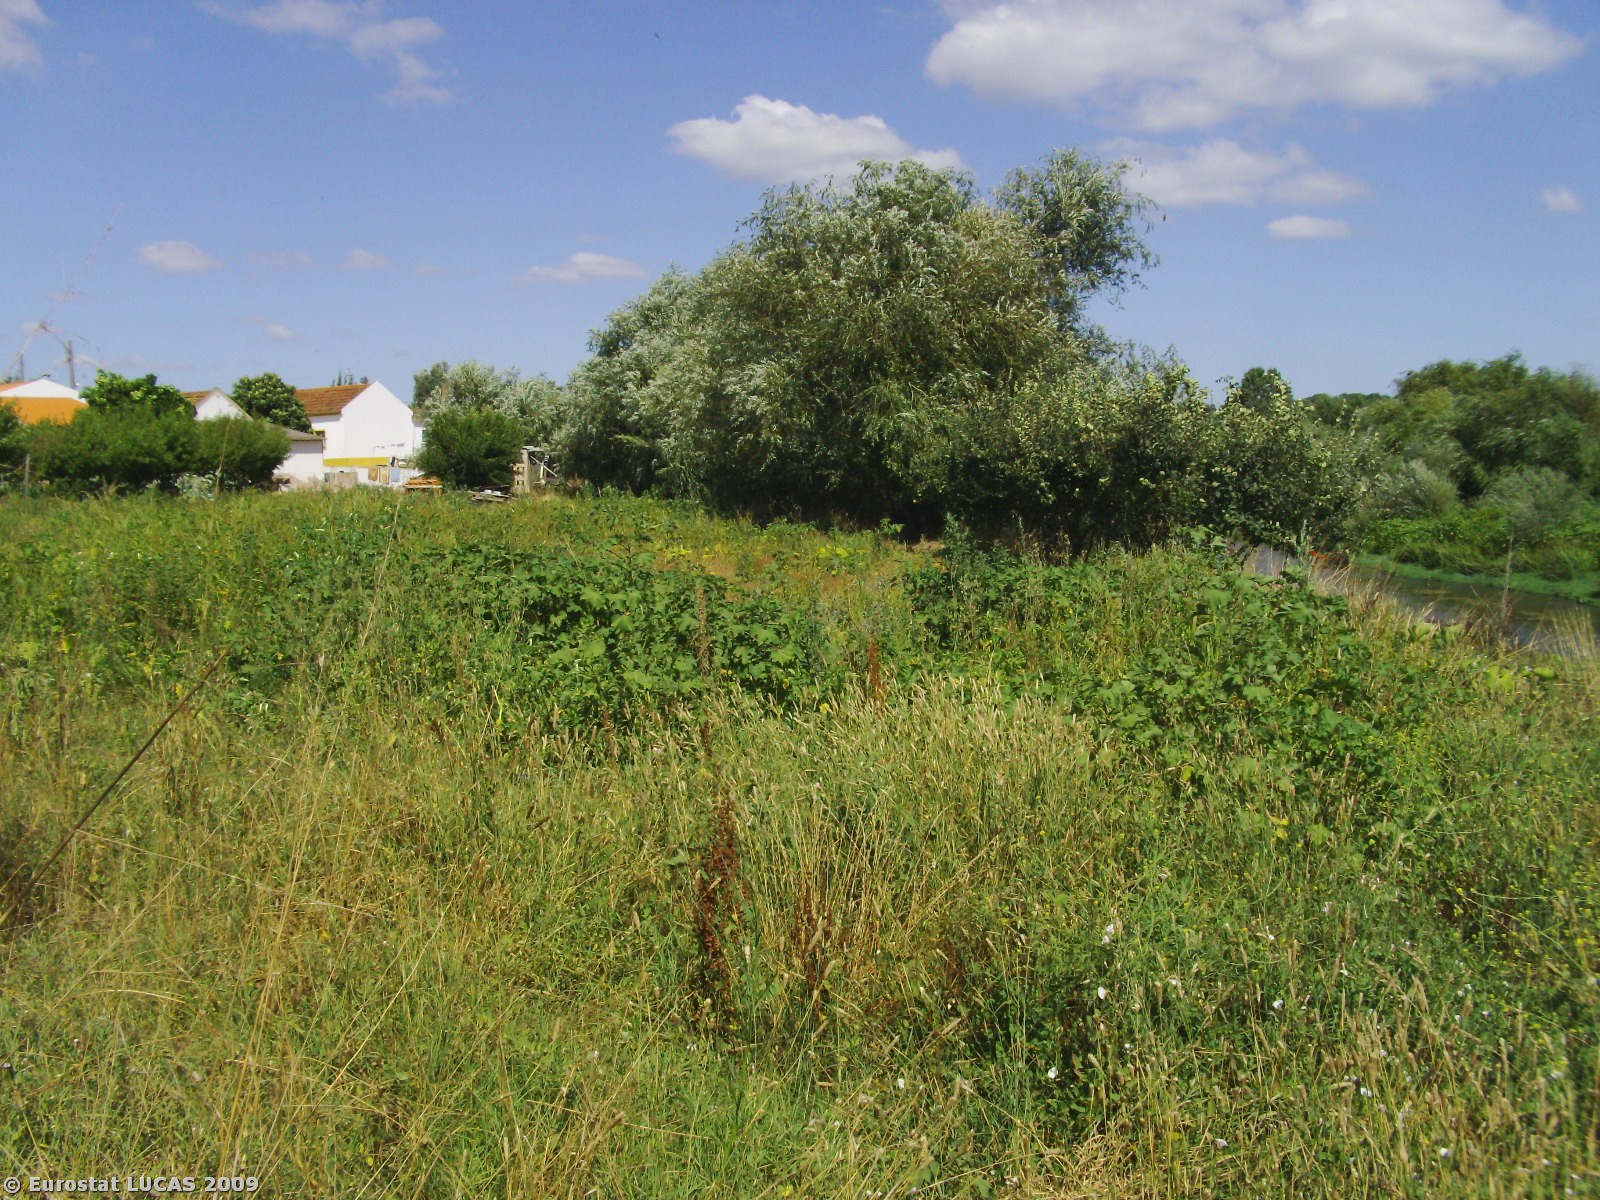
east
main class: Grassland
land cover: Spontaneously vegetated surfaces
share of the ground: 10 - 25 %
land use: Unused
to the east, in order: Spontaneously vegetated surfaces; Other fresh vegetables; Artificial constructions in urban areas; Tracks; Shrubland with sparse tree cover; Tracks; Spontaneously vegetated surfaces; Grassland with sparse tree/shrub cover; Oranges
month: July
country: PT
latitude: 38.9767
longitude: -8.7575
